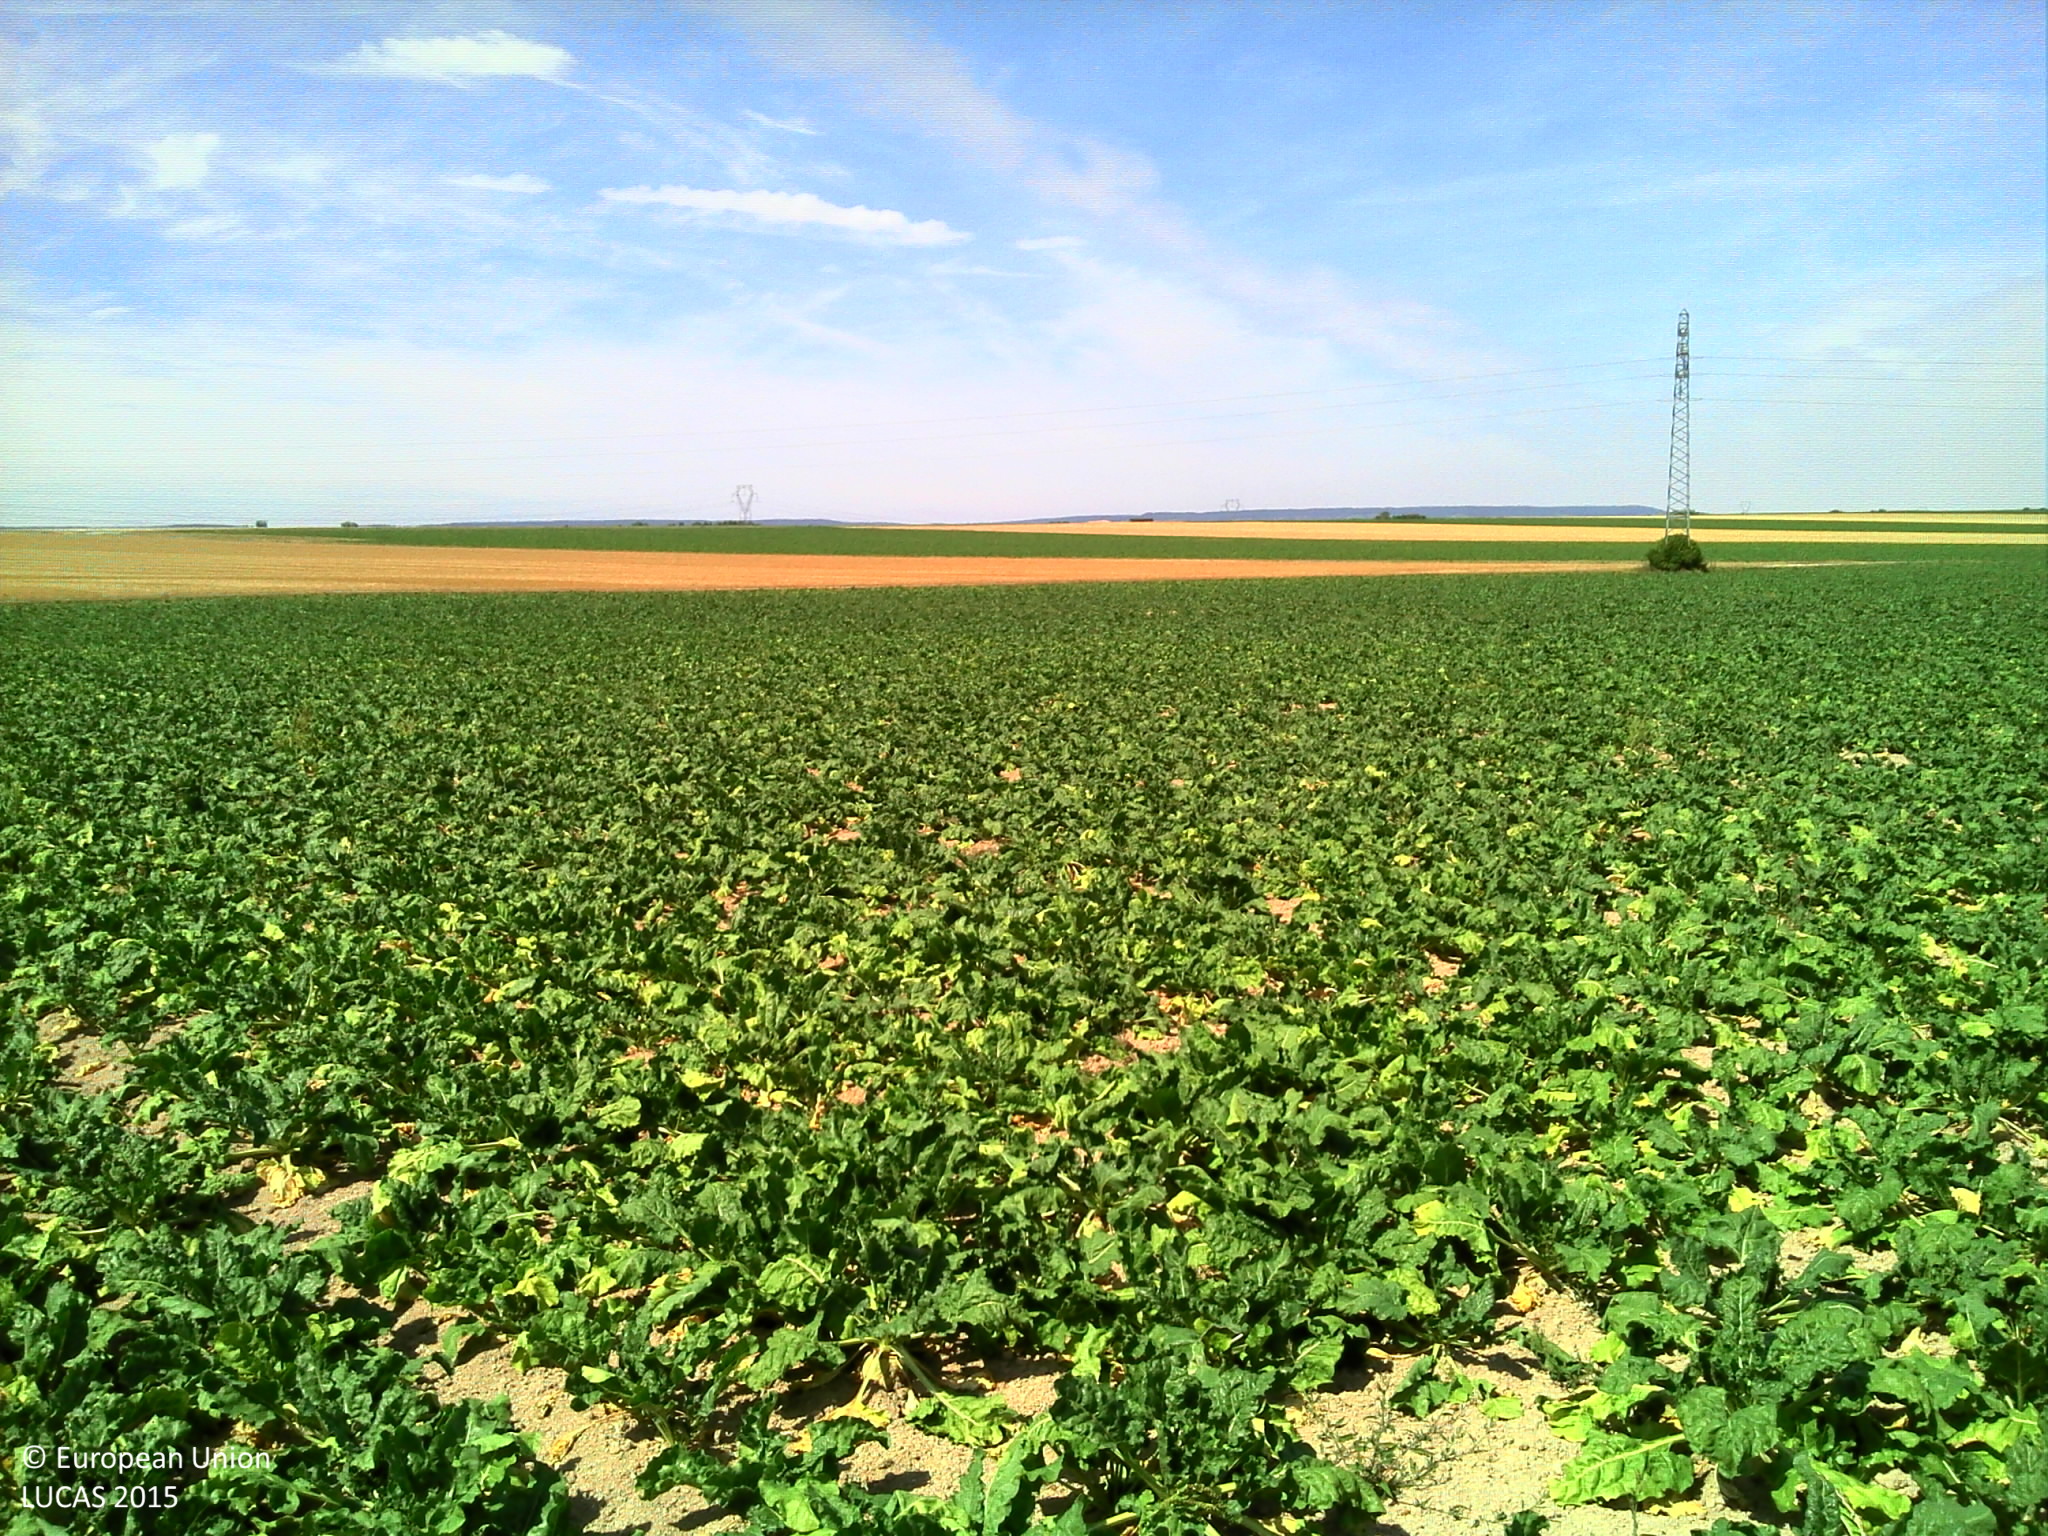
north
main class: Cropland
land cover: Sugar beet
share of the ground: > 75 %
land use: Agriculture (excluding fallow land and kitchen gardens)
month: August
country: FR
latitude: 48.9694
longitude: 4.1353
